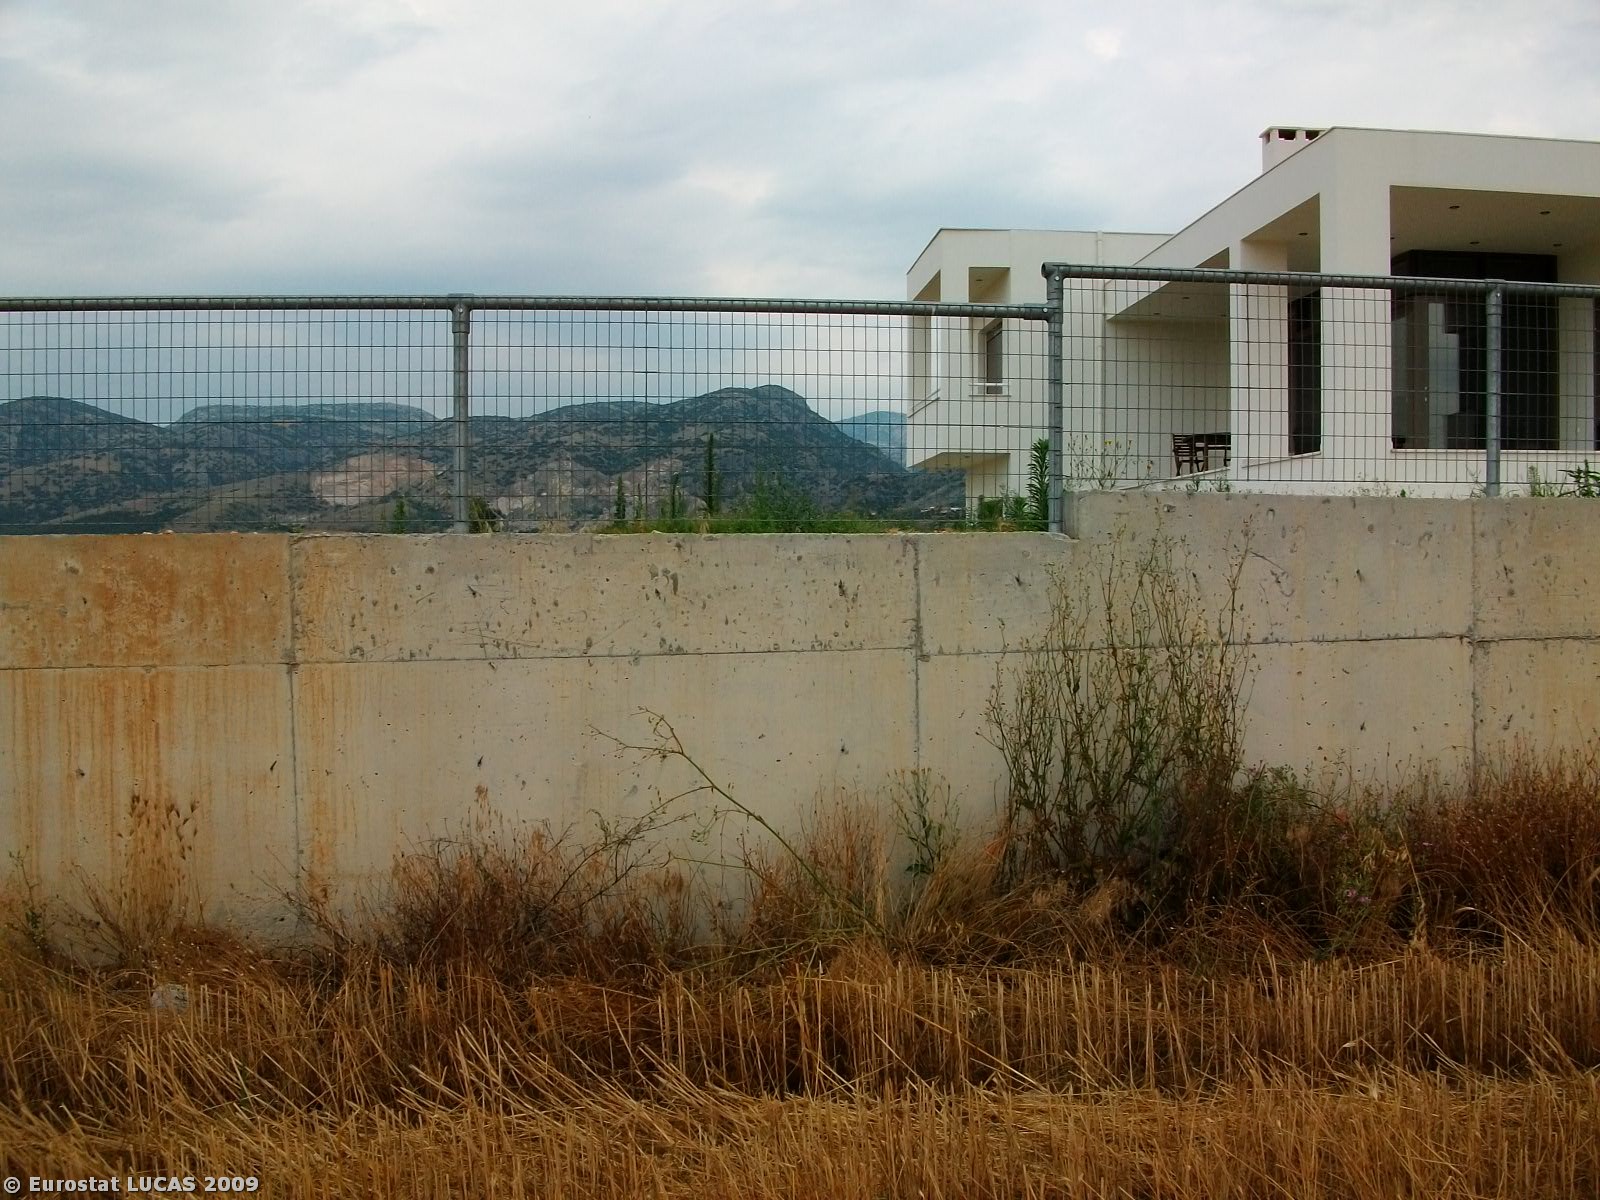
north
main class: Cropland
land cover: Durum wheat
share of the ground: > 75 %
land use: Agriculture (excluding fallow land and kitchen gardens)
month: June
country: GR
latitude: 41.0878
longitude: 23.6277
